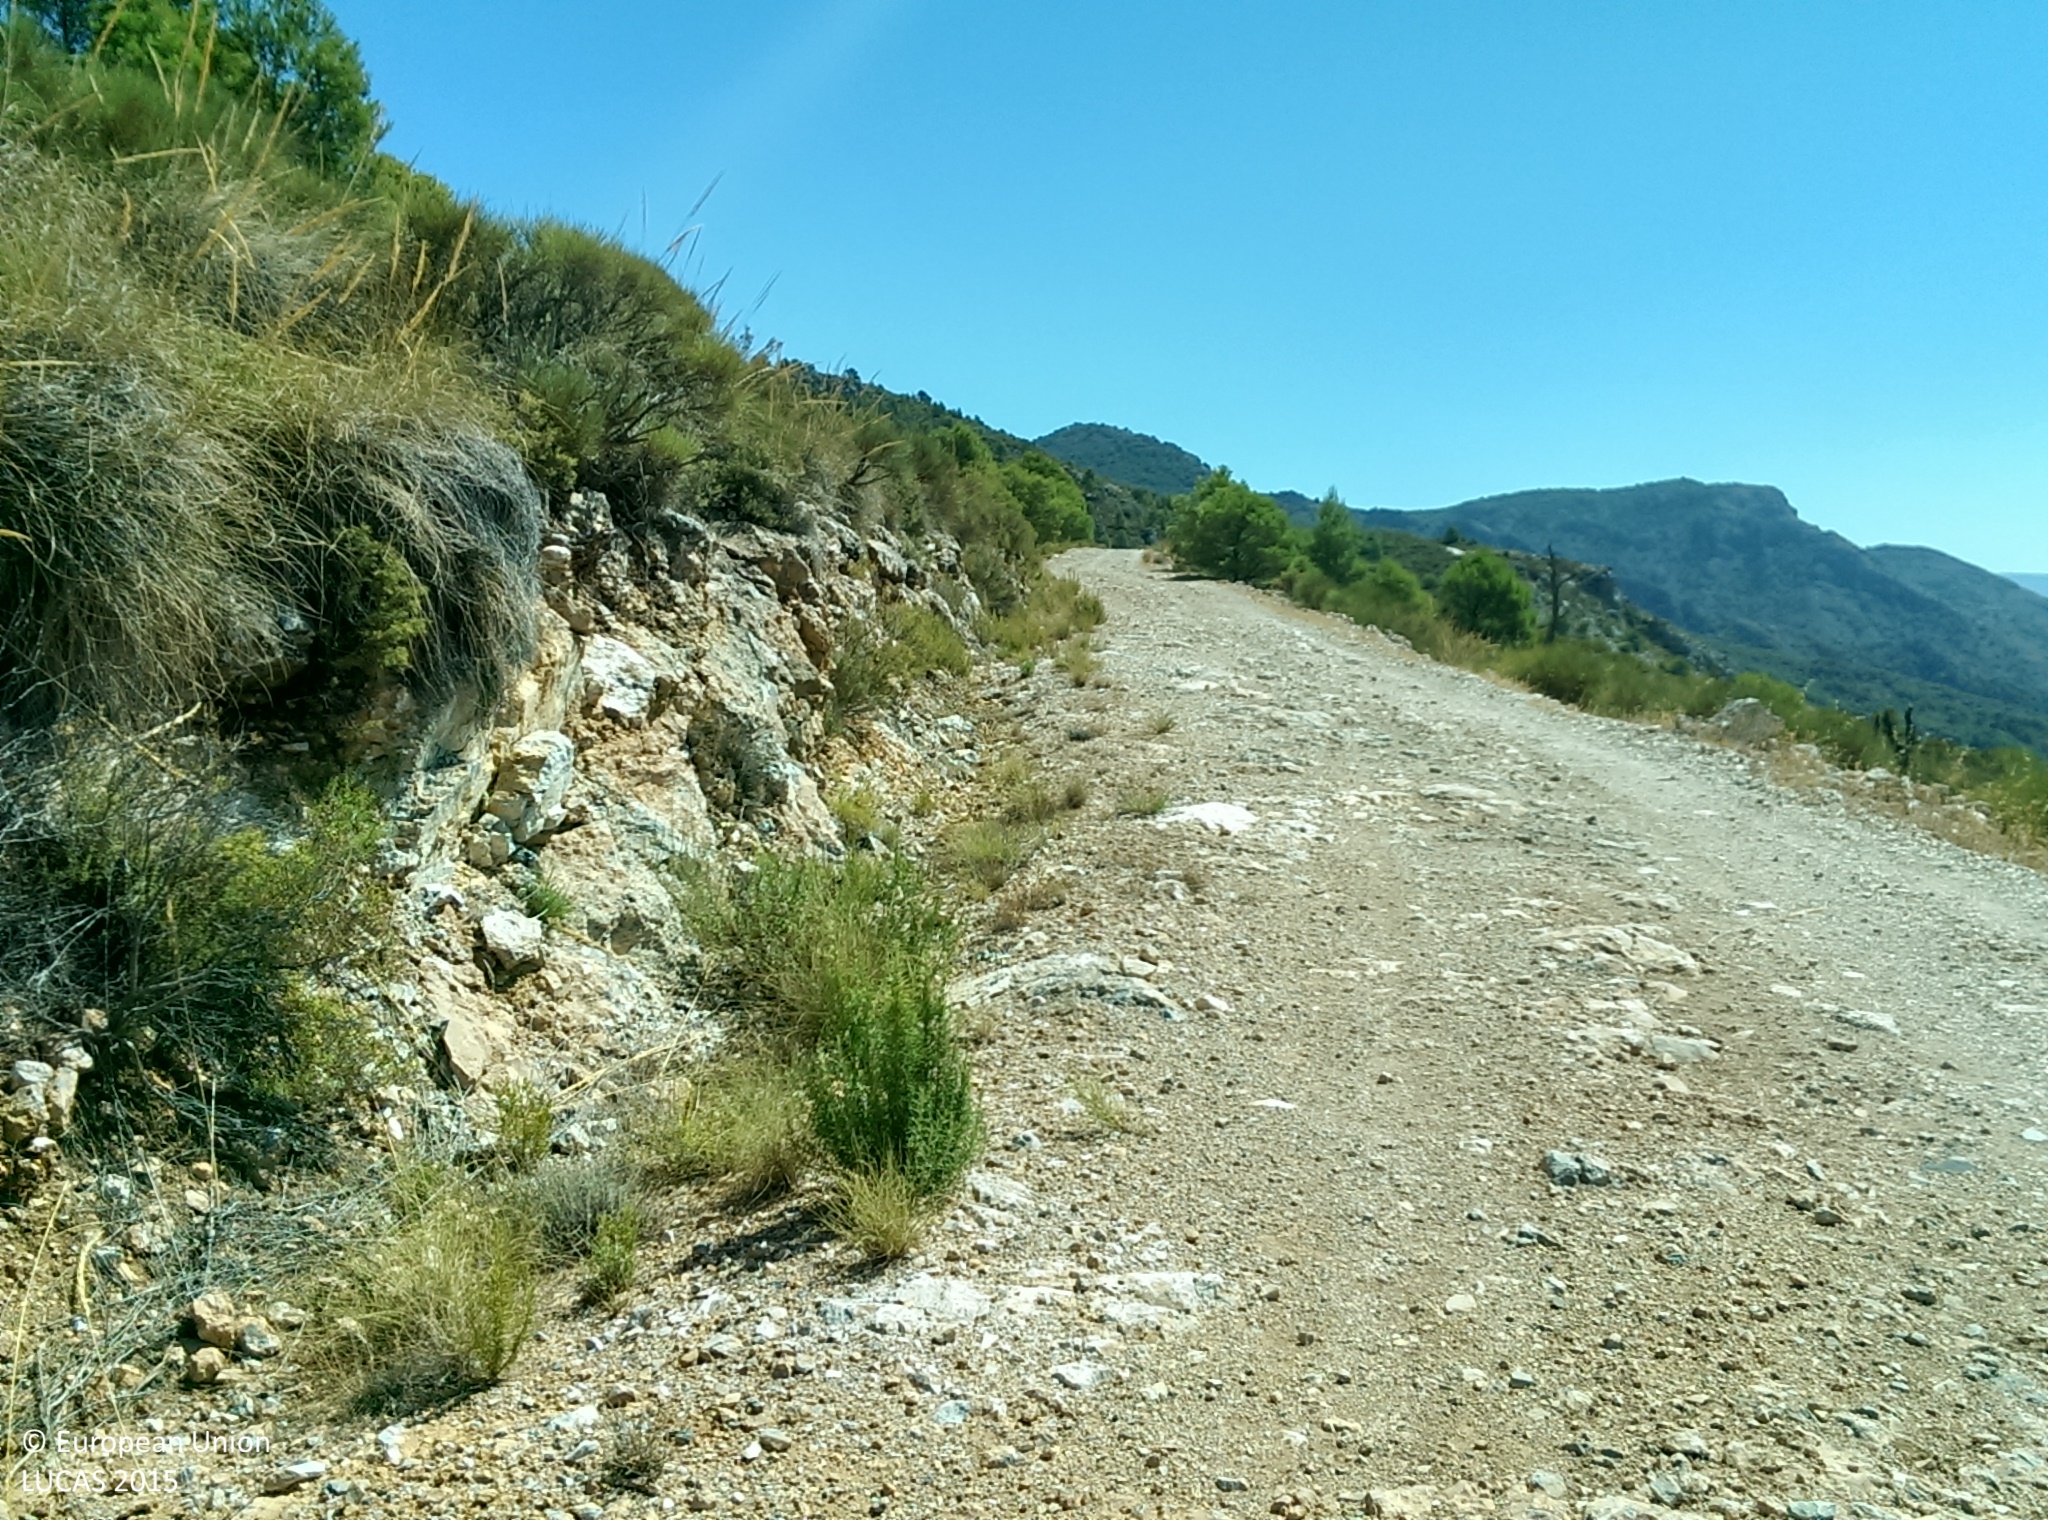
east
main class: Shrubland
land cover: Shrubland with sparse tree cover
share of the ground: > 75 %
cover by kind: shrubs 90 %, coniferous forest trees 5 %, herbaceous plants 5 %
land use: Semi-natural and natural areas not in use
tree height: < 5 m
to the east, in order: Shrubland with sparse tree cover; Nuts trees; Grass margins; Tracks; Shrubland without tree cover; Nuts trees; Rivers and streams; Nuts trees; Shrubland without tree cover
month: August
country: ES
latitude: 36.8736
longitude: -3.6148
